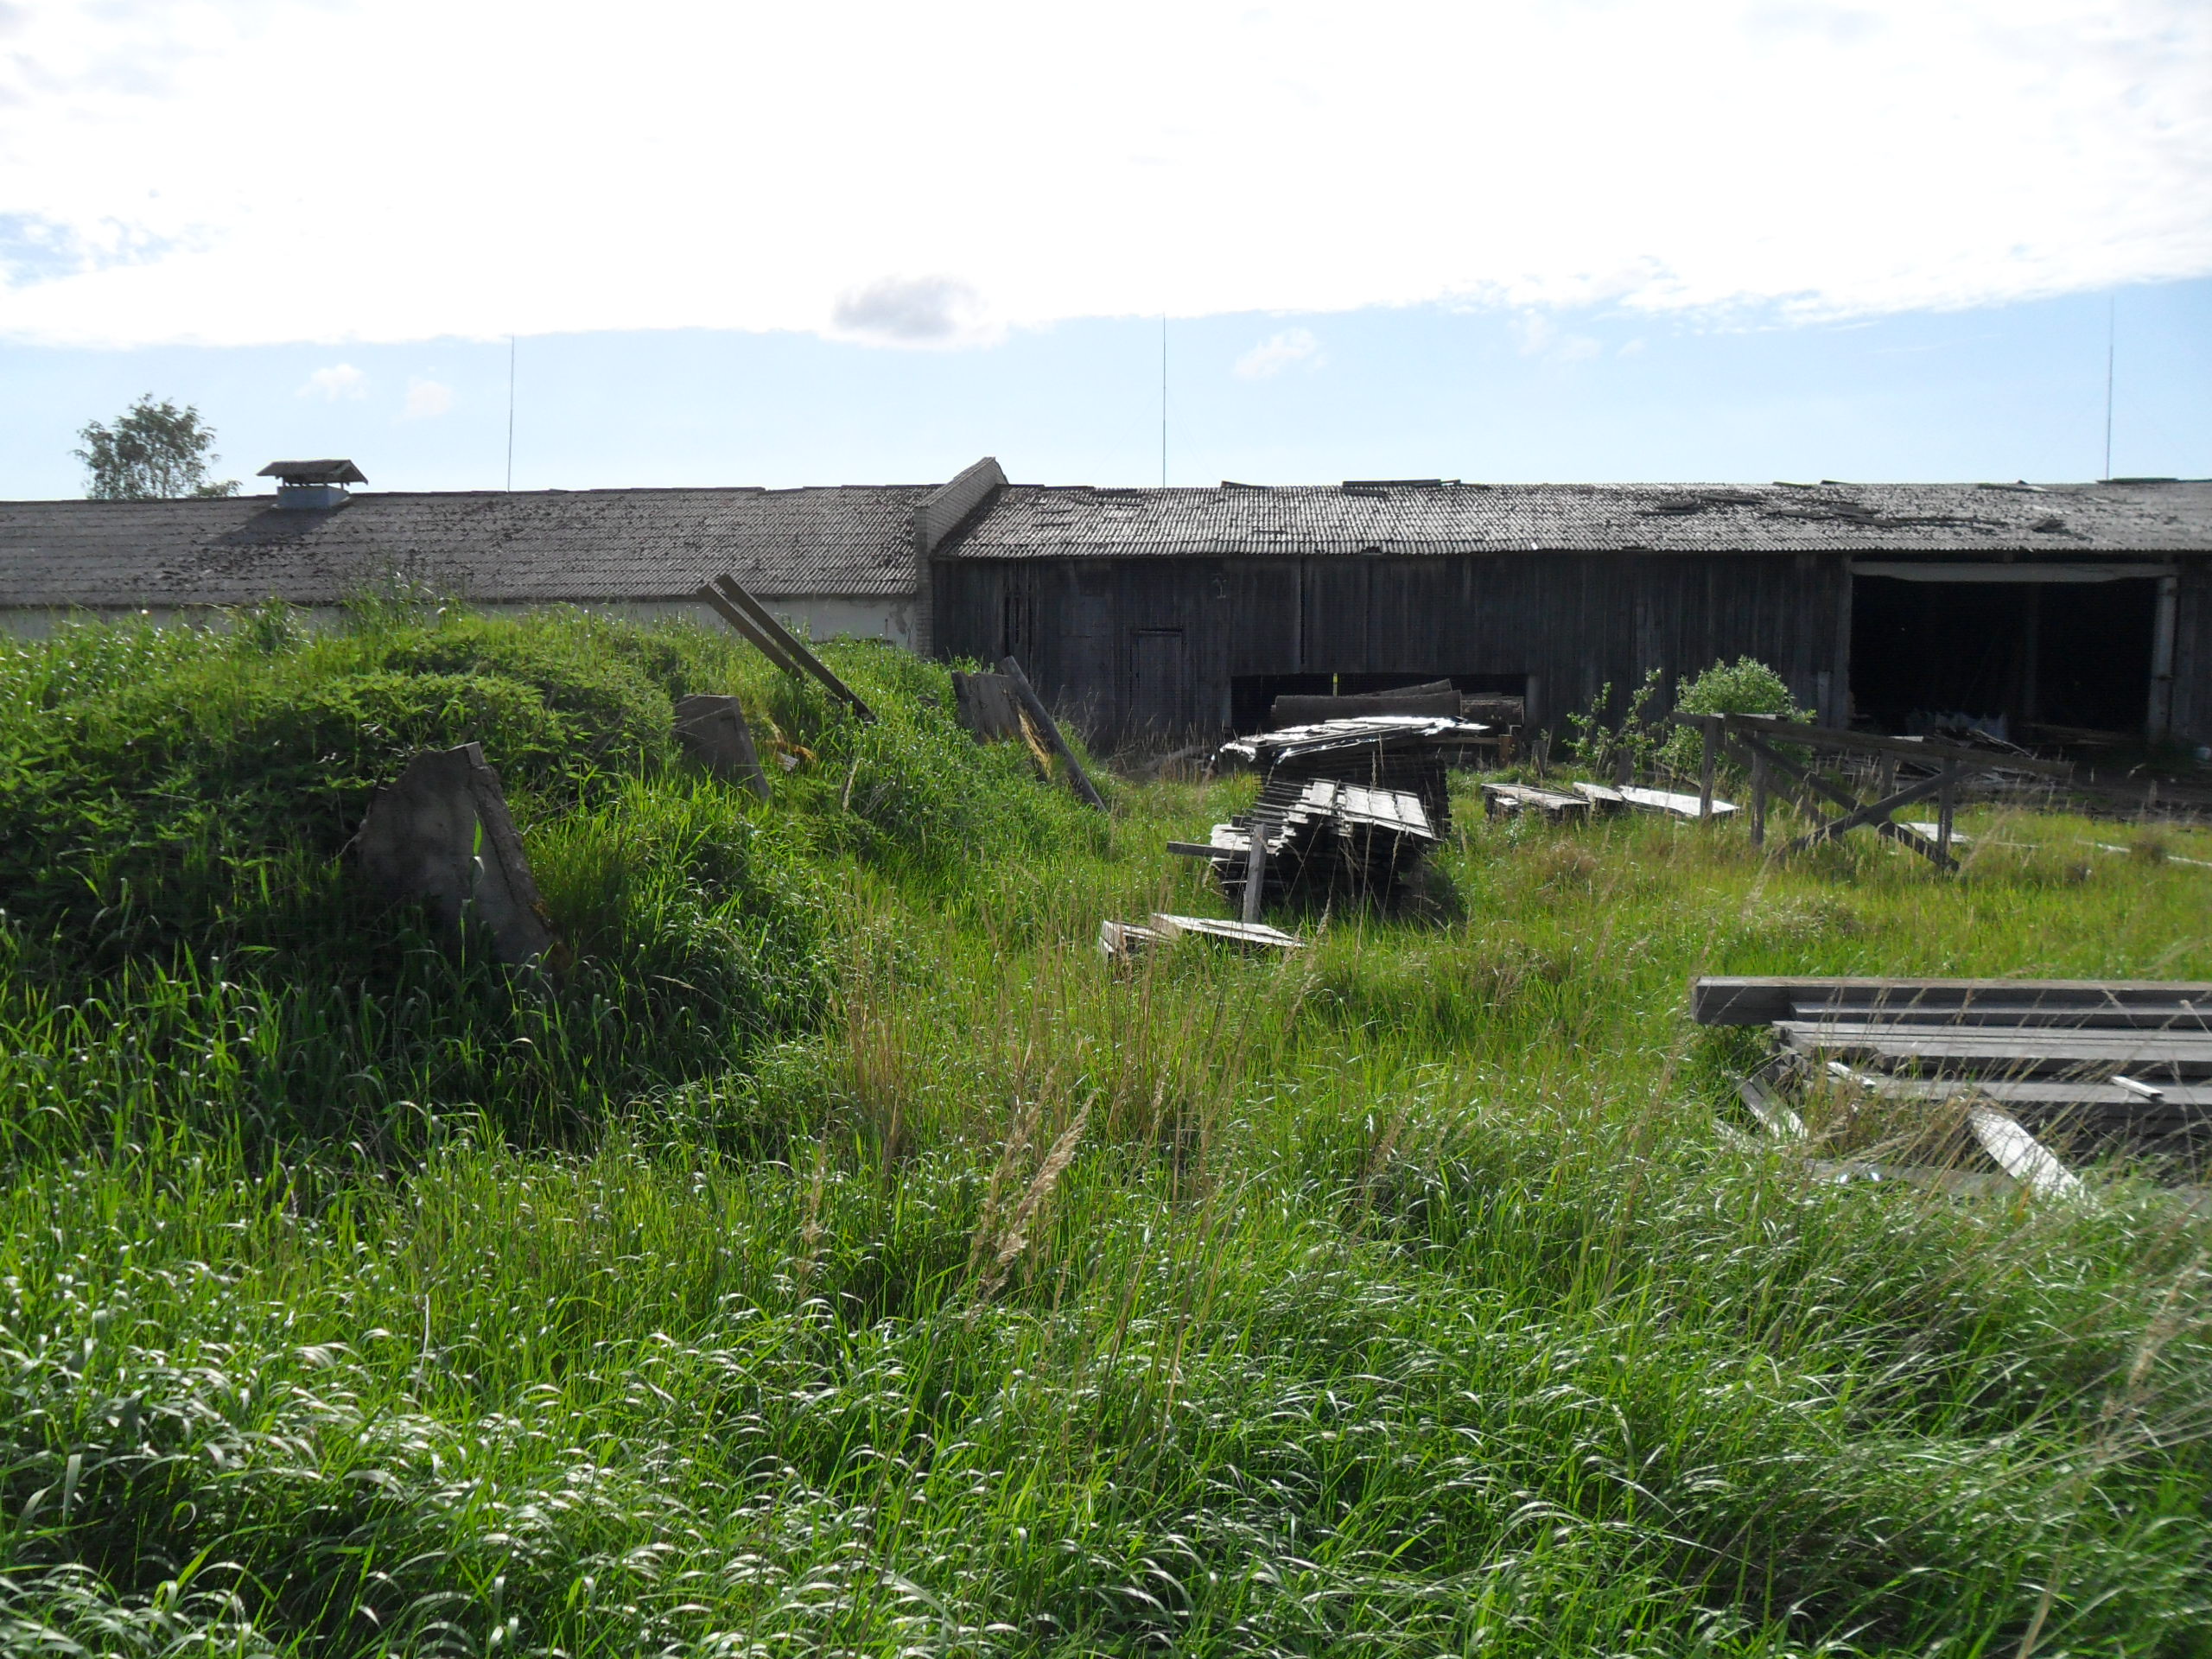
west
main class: Grassland
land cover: Grassland without tree/shrub cover
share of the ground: > 75 %
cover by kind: herbaceous plants 75 %
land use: Abandoned areas
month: June
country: LV
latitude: 57.3799
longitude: 22.4775
